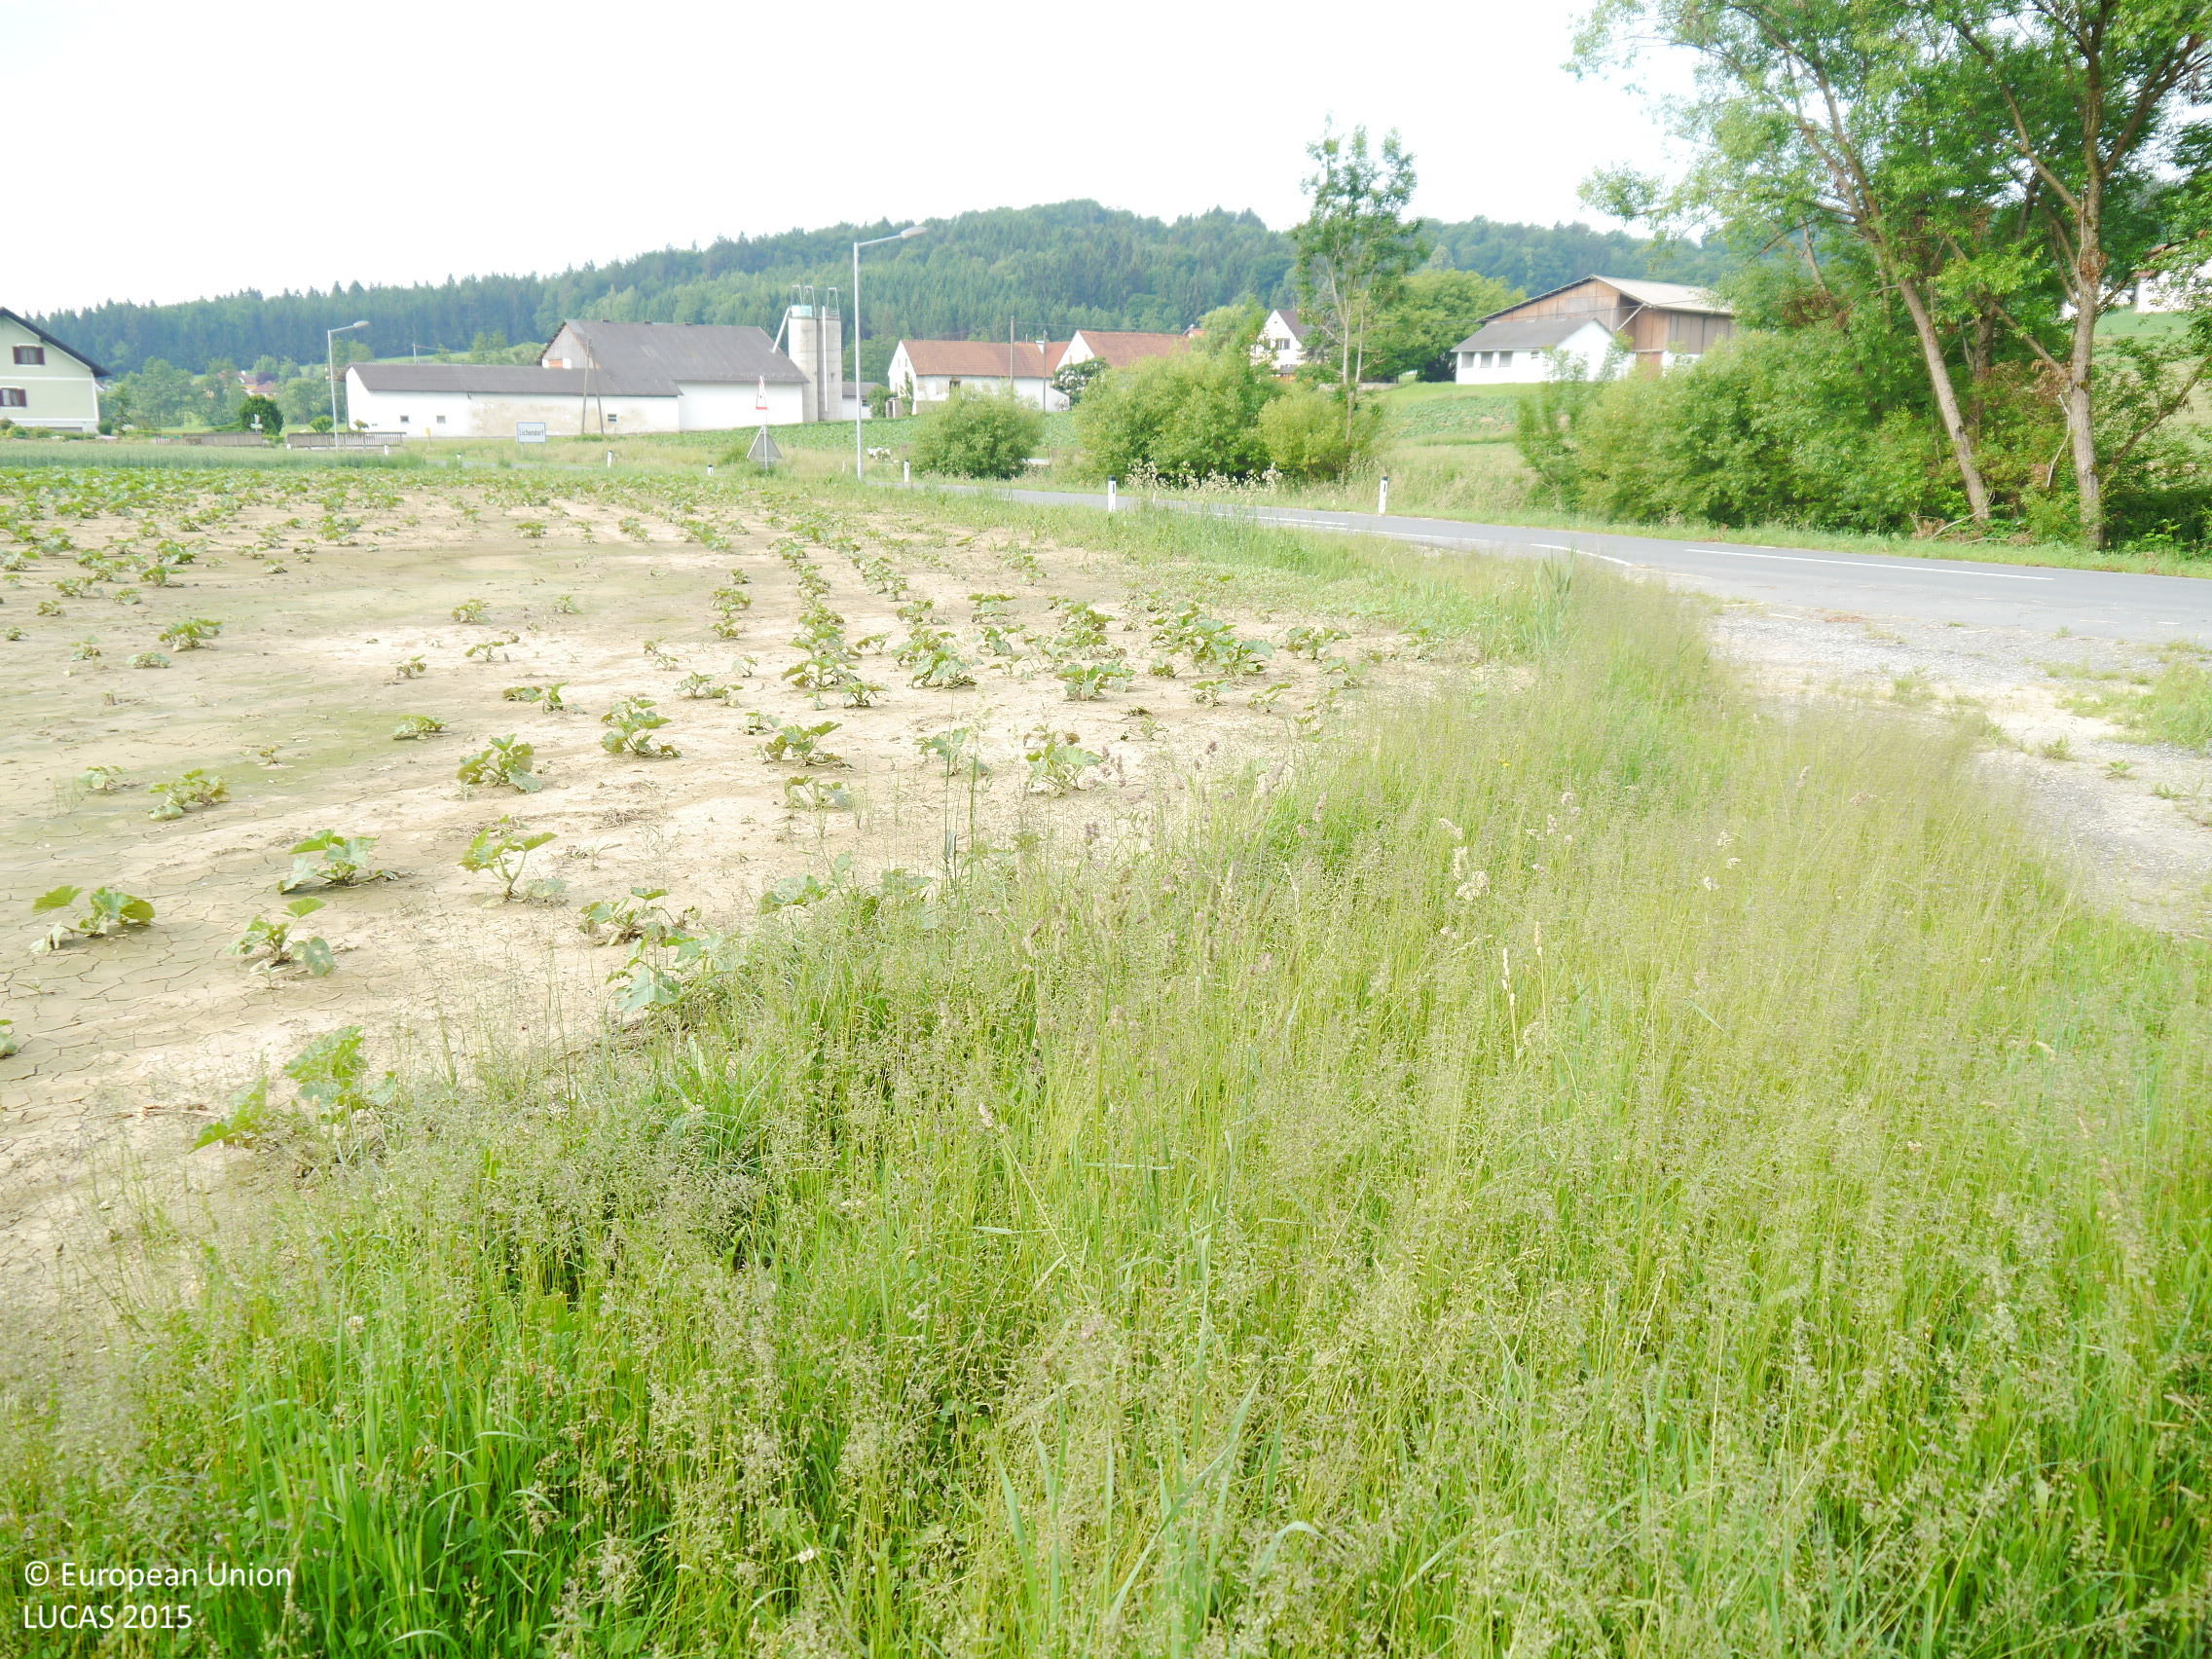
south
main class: Grassland
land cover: Grassland without tree/shrub cover
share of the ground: > 75 %
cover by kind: herbaceous plants 100 %
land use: Agriculture (excluding fallow land and kitchen gardens)
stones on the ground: < 10 %
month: June
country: AT
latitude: 46.9386
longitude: 15.7144
